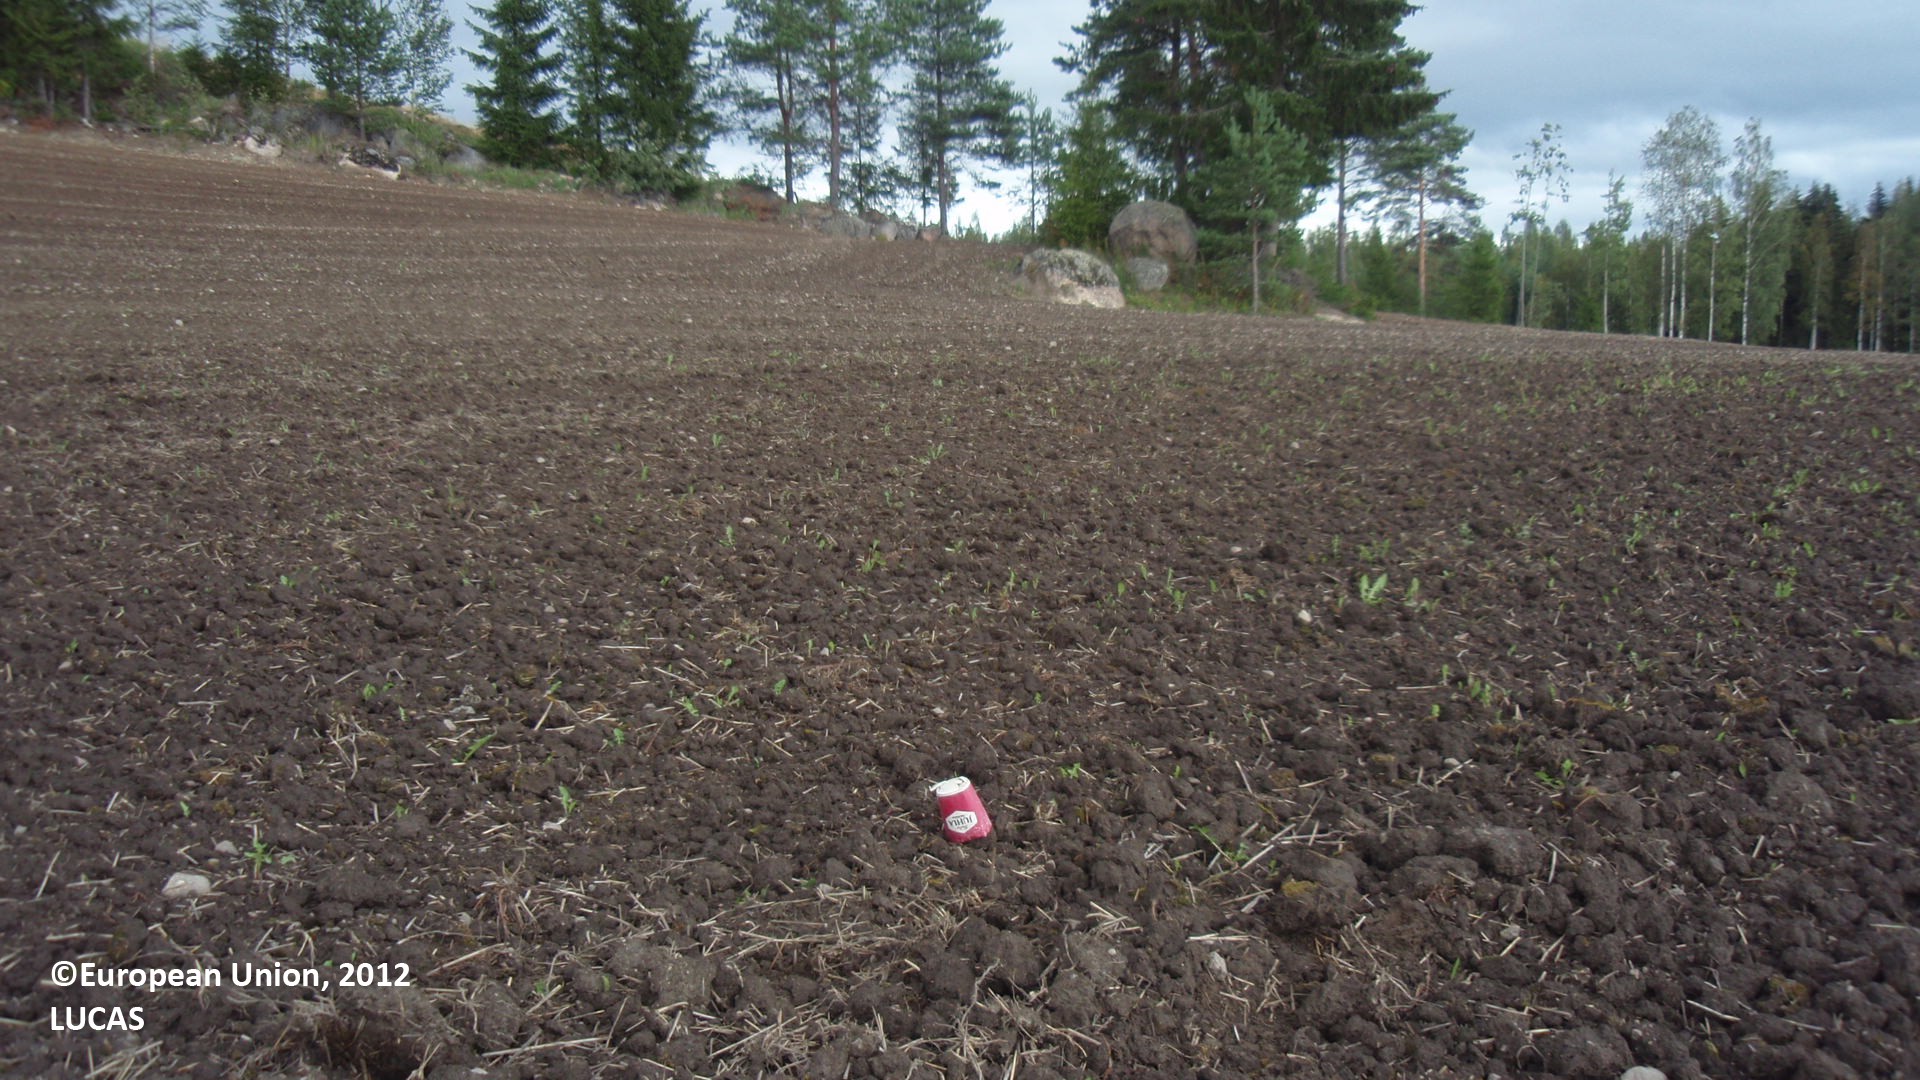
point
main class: Cropland
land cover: Oats
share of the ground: > 75 %
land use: Agriculture (excluding fallow land and kitchen gardens)
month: August
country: FI
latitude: 61.0115
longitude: 27.0946
